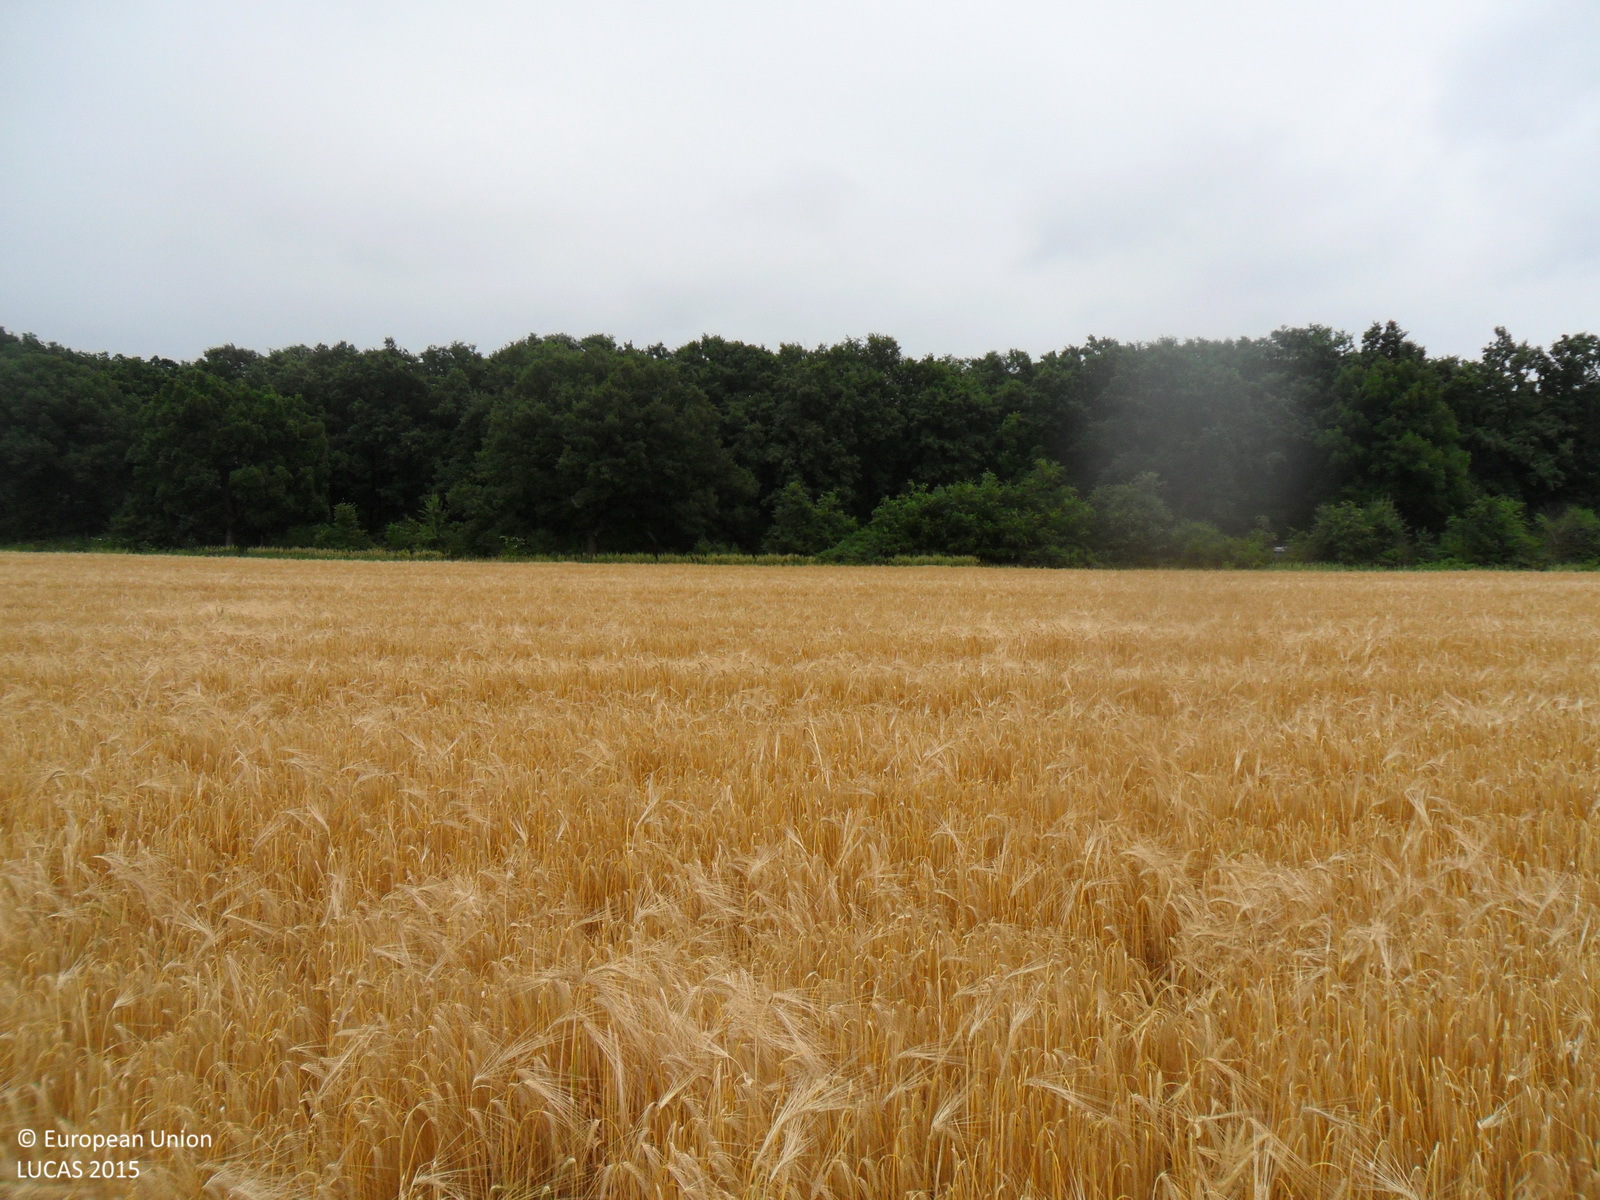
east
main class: Cropland
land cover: Common wheat
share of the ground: > 75 %
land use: Agriculture (excluding fallow land and kitchen gardens)
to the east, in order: Common wheat; Shrubland without tree cover; Lines of trees; Paved roads, cycling and walking lanes; Shruby margins; Fences; Broadleaved woodland
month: June
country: BG
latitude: 43.7318
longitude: 26.6352
